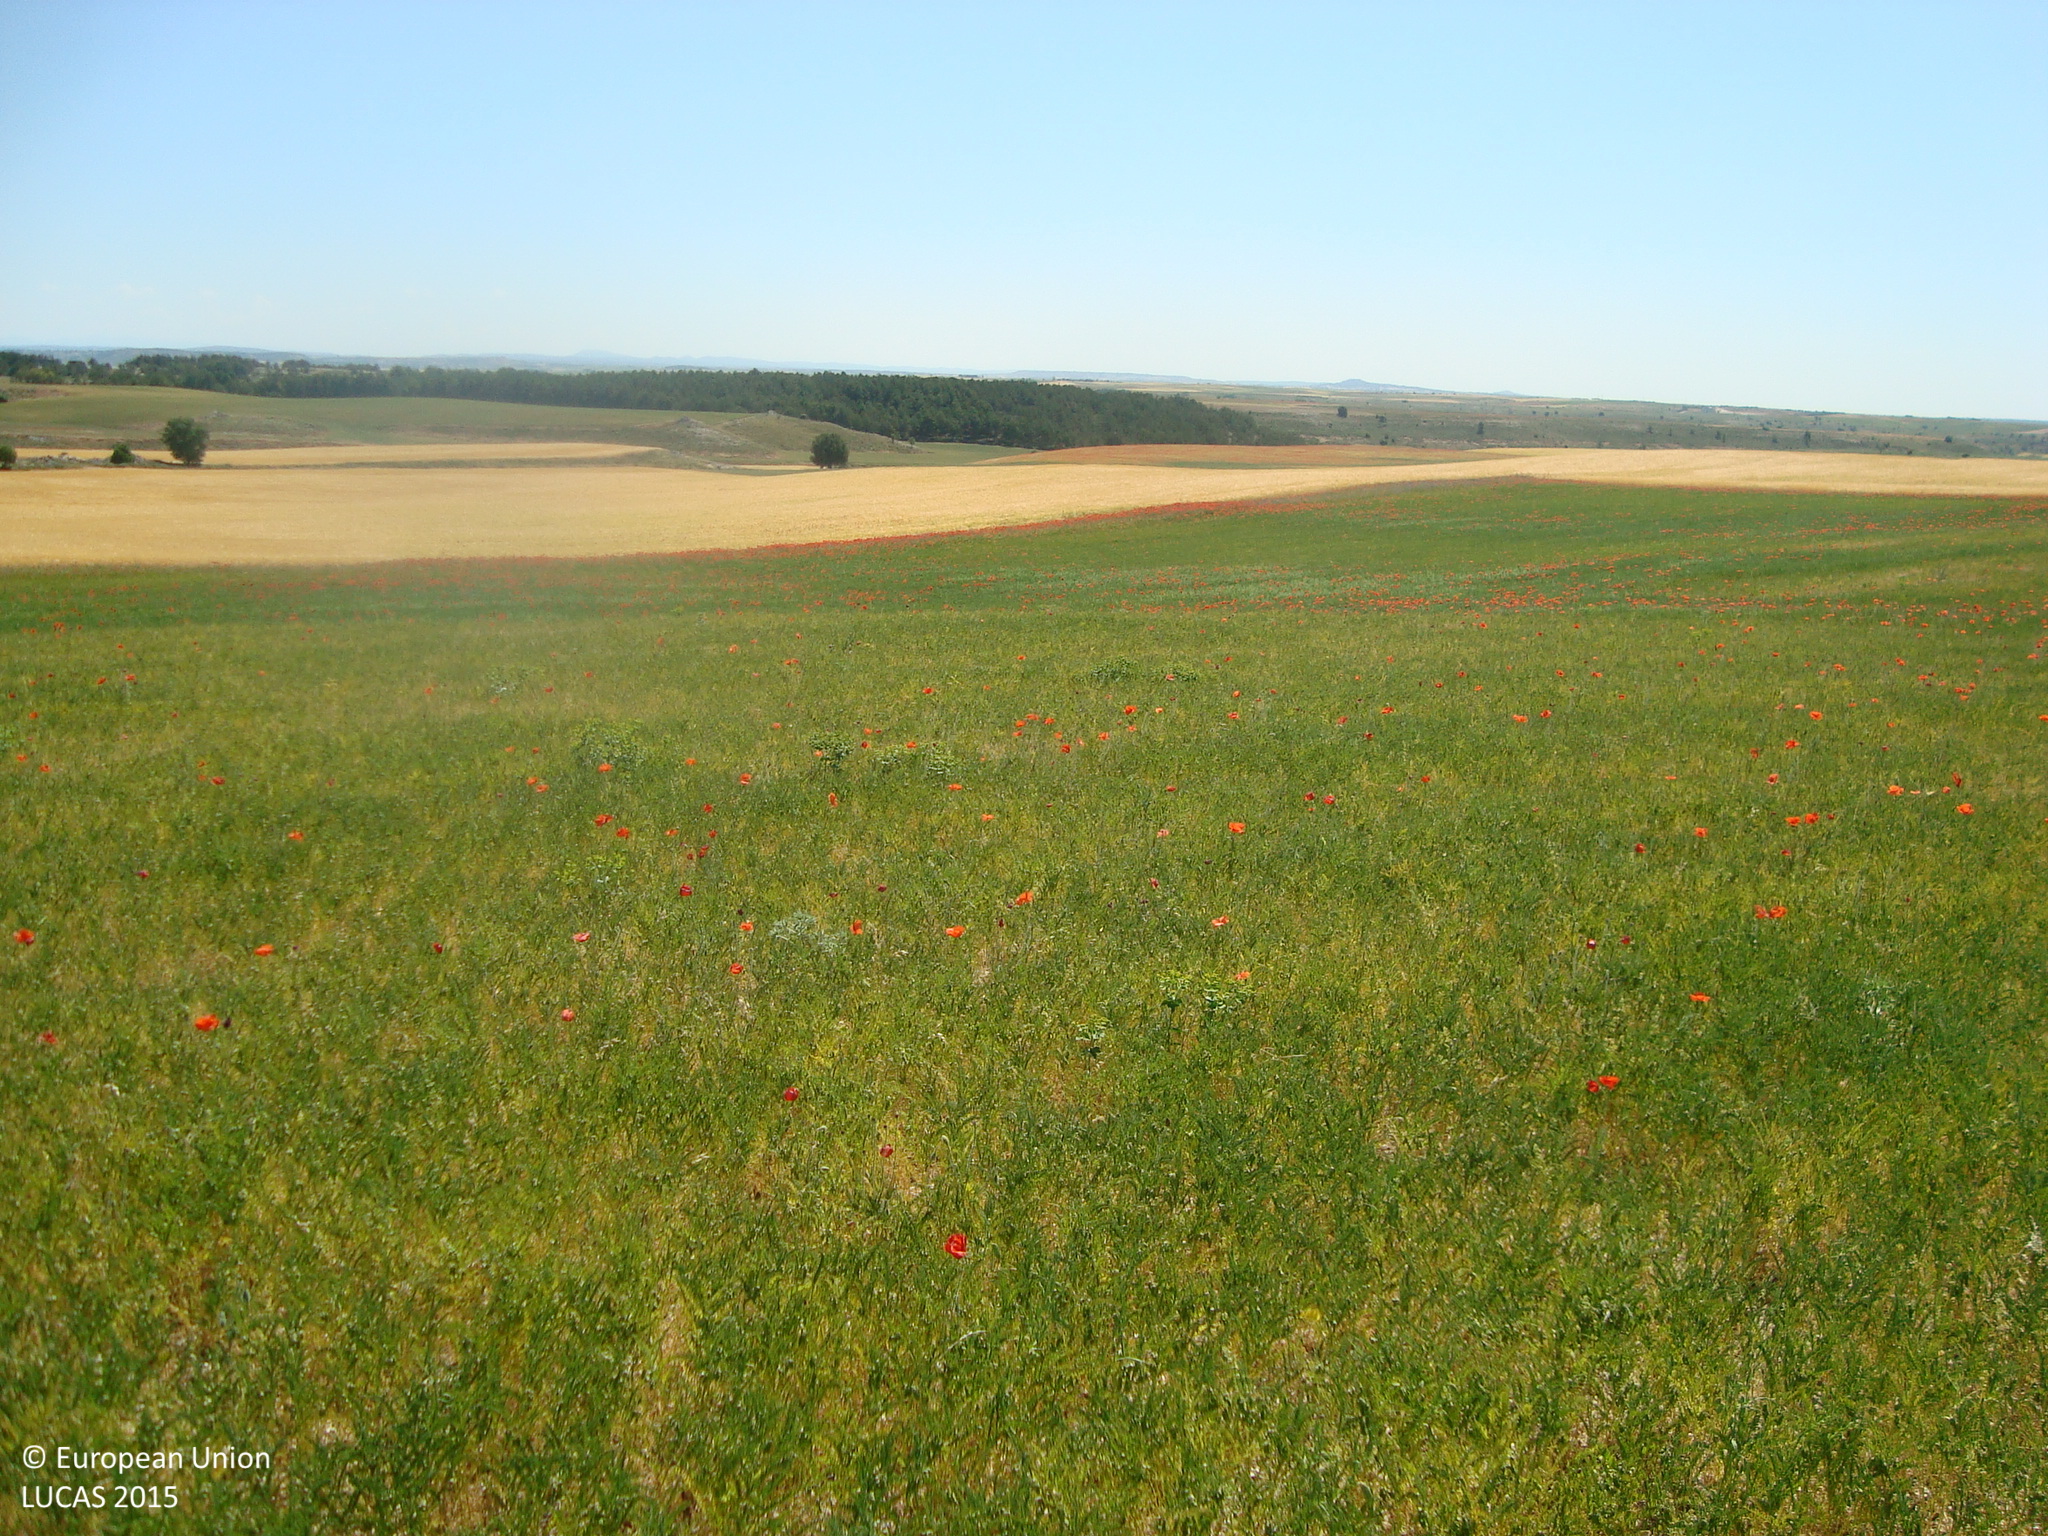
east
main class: Cropland
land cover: Dry pulses
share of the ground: 50 - 75 %
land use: Agriculture (excluding fallow land and kitchen gardens)
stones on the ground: < 10 %
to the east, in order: Dry pulses; Barley
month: June
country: ES
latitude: 41.8027
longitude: -3.6175
